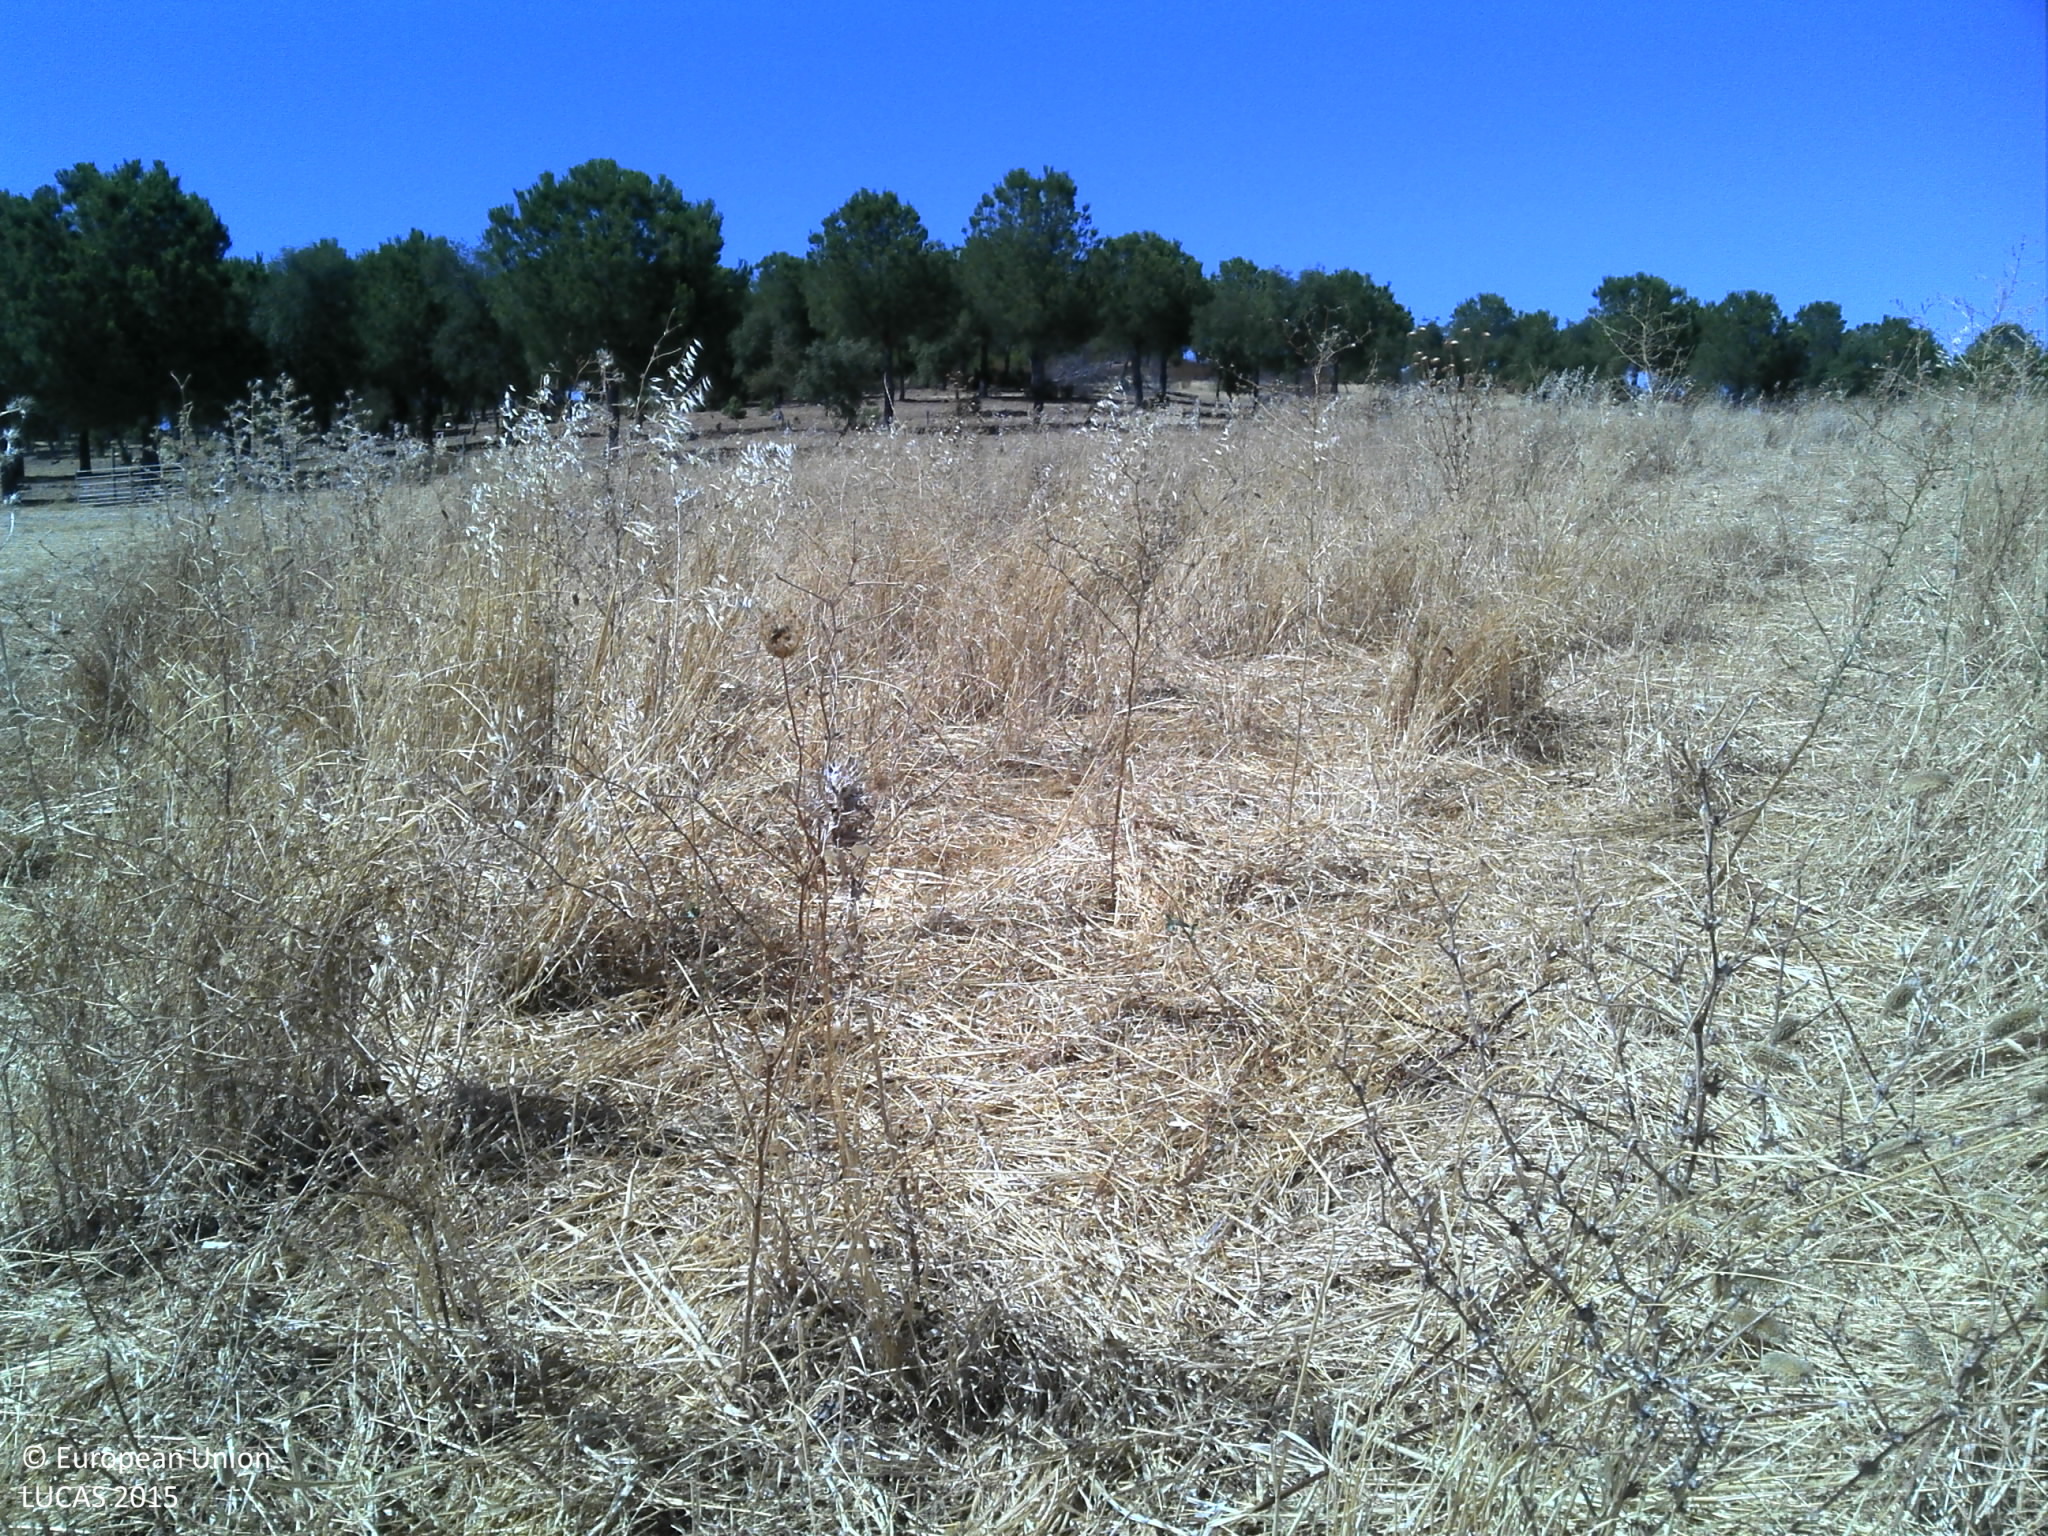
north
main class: Grassland
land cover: Grassland without tree/shrub cover
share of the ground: > 75 %
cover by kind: herbaceous plants 85 %, unconsolidated bare surface 15 %
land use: Agriculture (excluding fallow land and kitchen gardens)
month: July
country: PT
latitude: 38.1577
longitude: -7.7281
